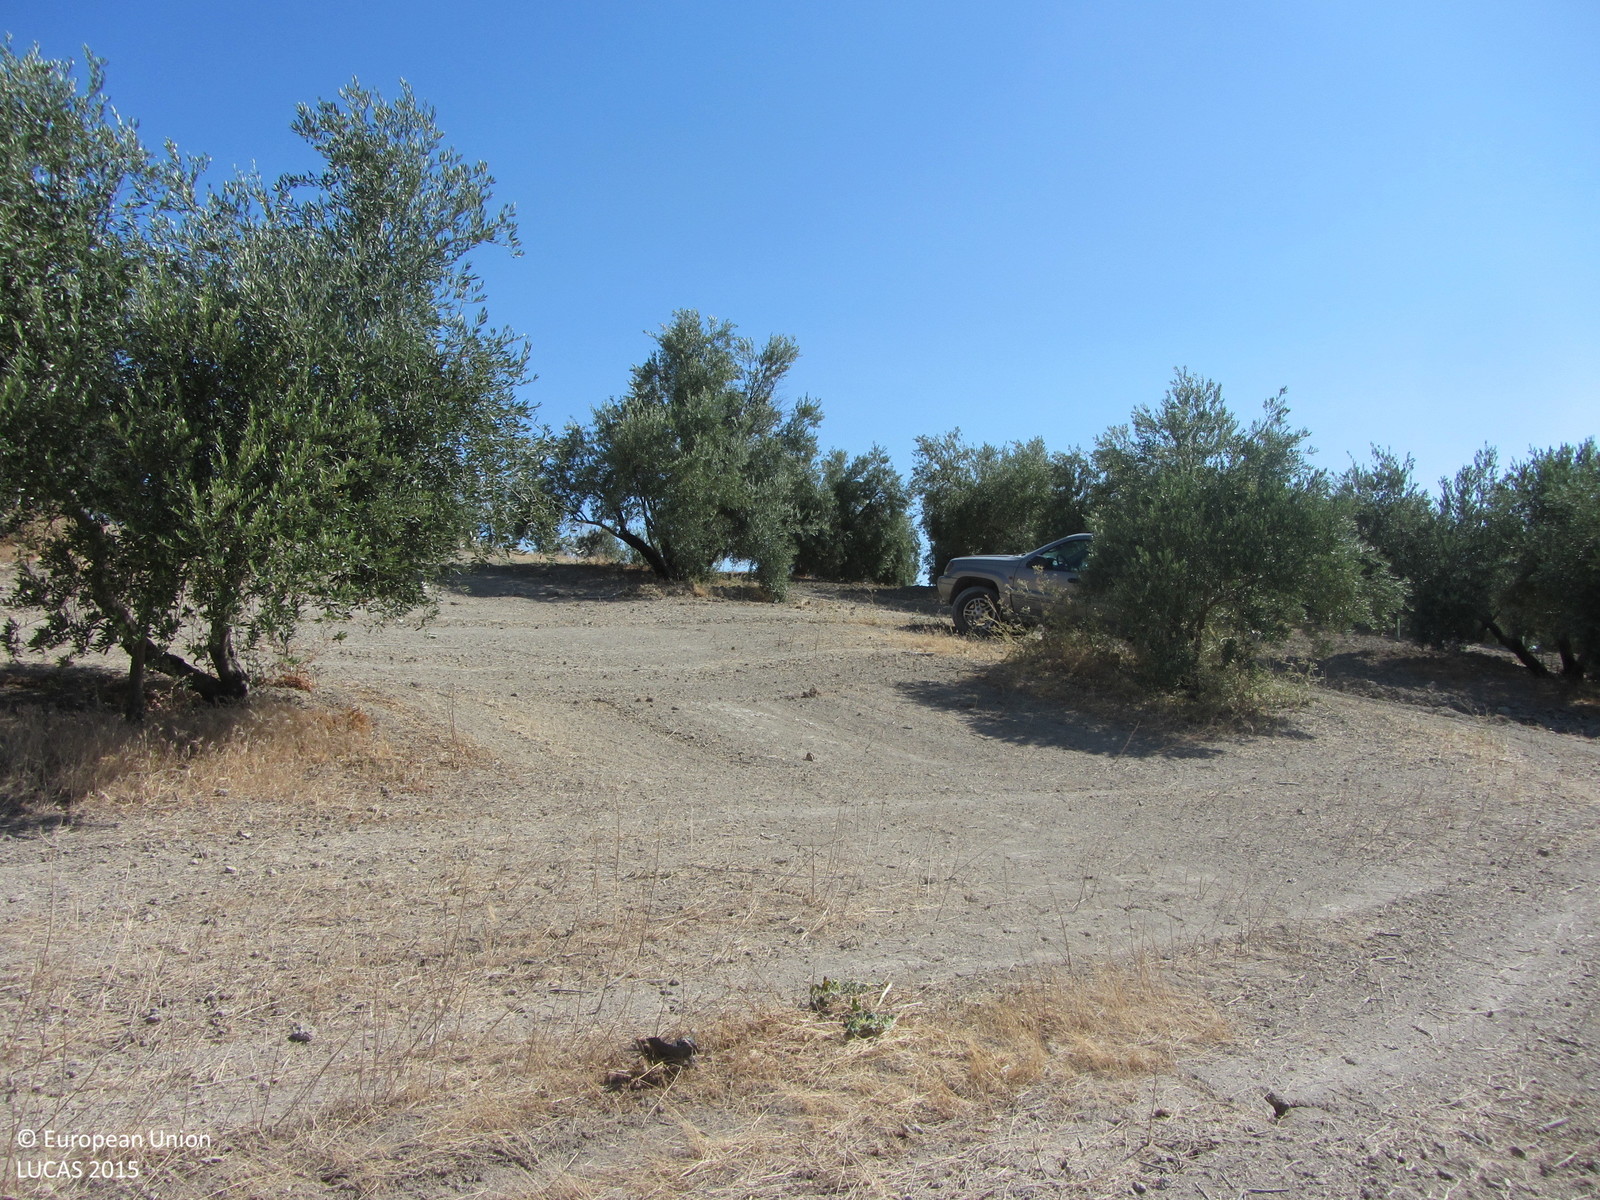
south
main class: Cropland
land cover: Olive groves
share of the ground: 25 - 50 %
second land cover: Other bare soil
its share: > 75 %
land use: Agriculture (excluding fallow land and kitchen gardens)
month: July
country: ES
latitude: 37.9761
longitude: -3.8592
